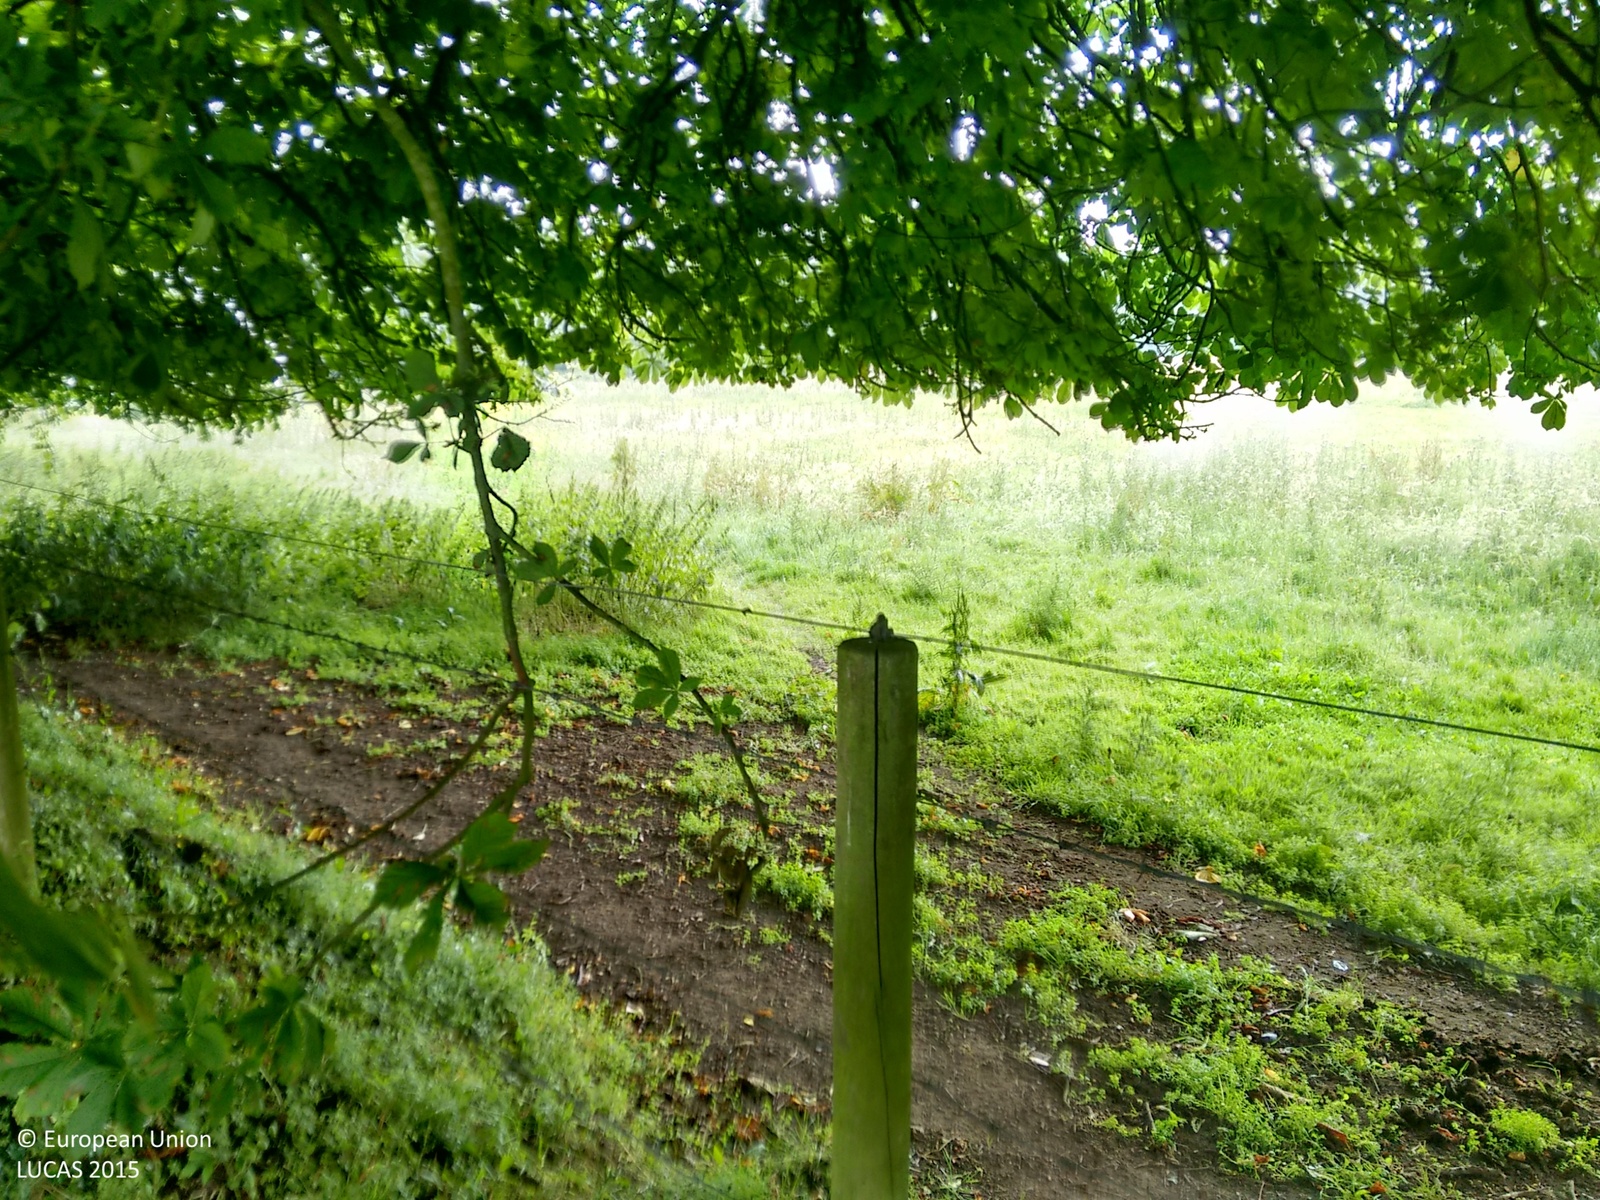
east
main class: Grassland
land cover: Grassland without tree/shrub cover
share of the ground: > 75 %
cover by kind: herbaceous plants 100 %
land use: Agriculture (excluding fallow land and kitchen gardens)
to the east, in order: Grassland without tree/shrub cover; Fences; Broadleaved woodland; Ditches and canals; Fences; Grassland without tree/shrub cover
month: July
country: IE
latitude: 52.6561
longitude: -7.4385
